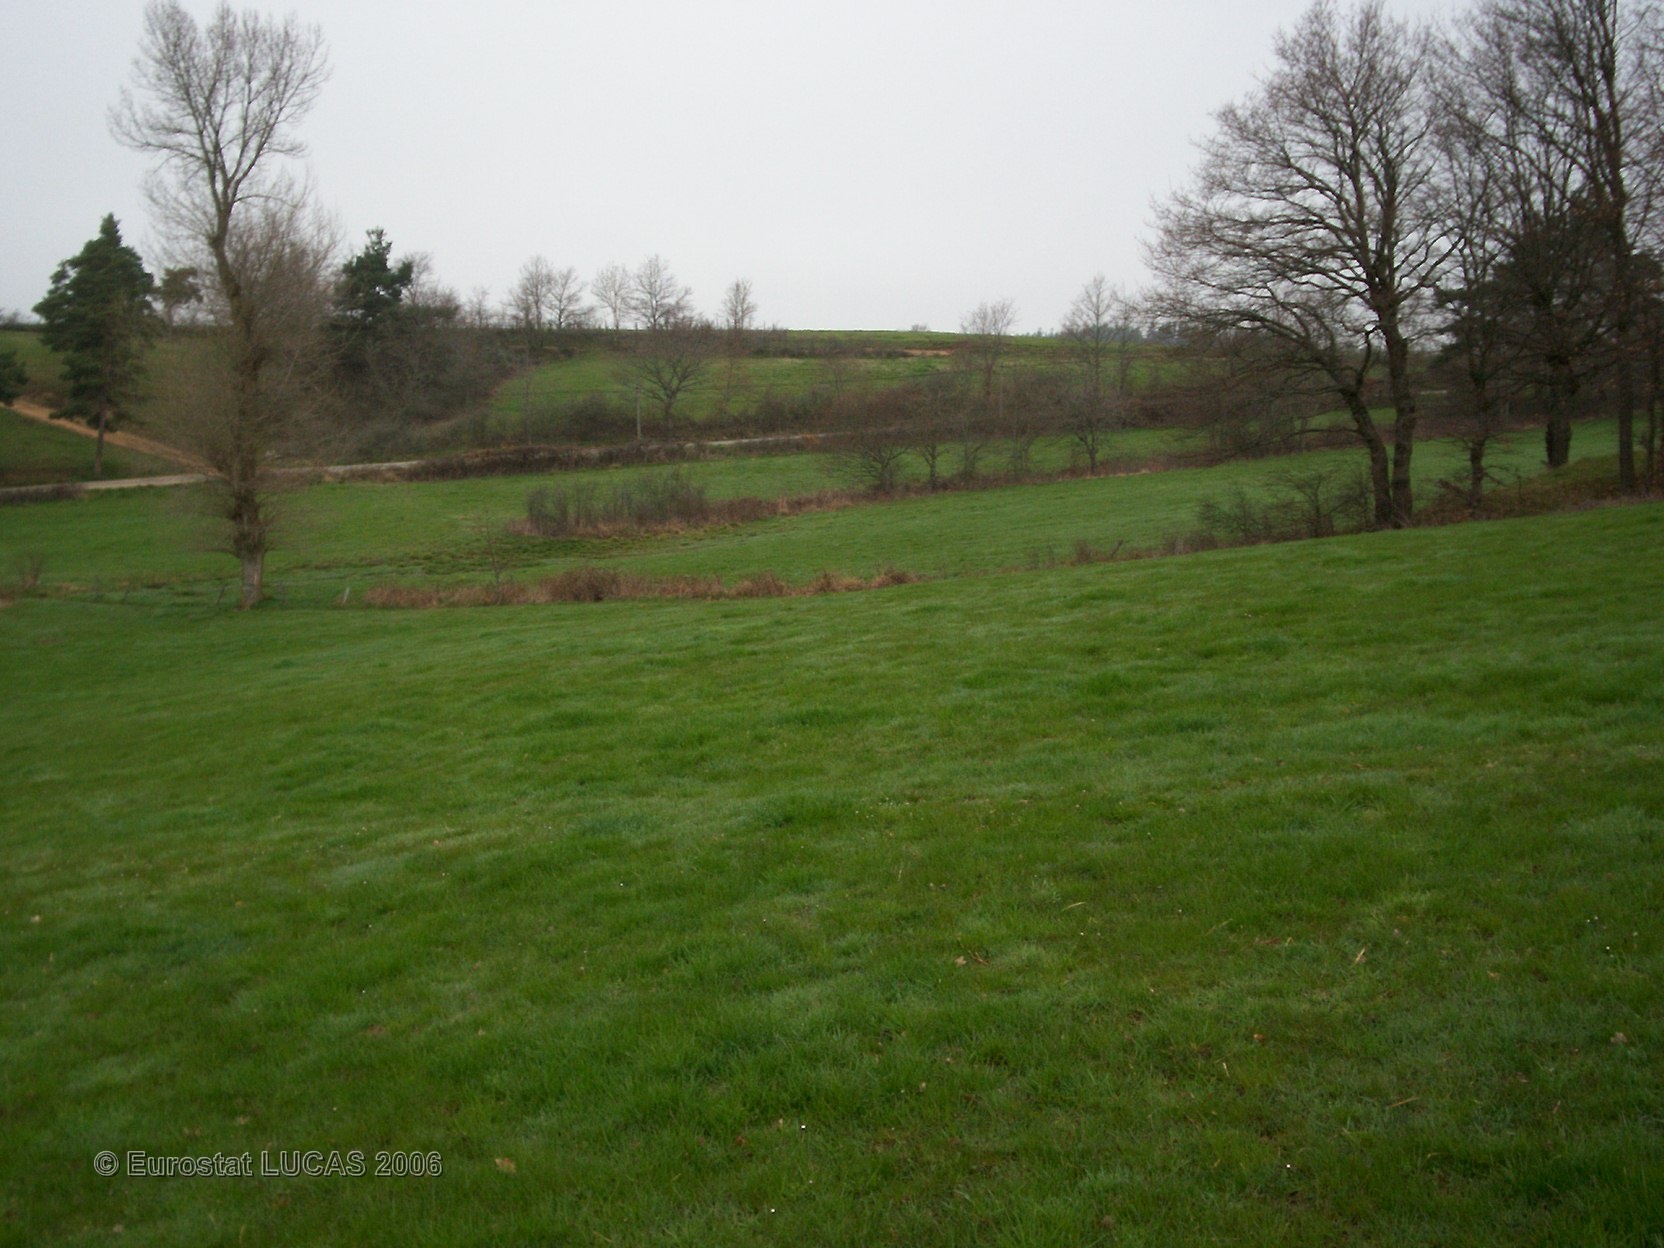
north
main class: Grassland
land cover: Grassland without tree/shrub cover
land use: Agriculture (excluding fallow land and kitchen gardens)
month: April
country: FR
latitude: 44.9462
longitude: 3.2732
